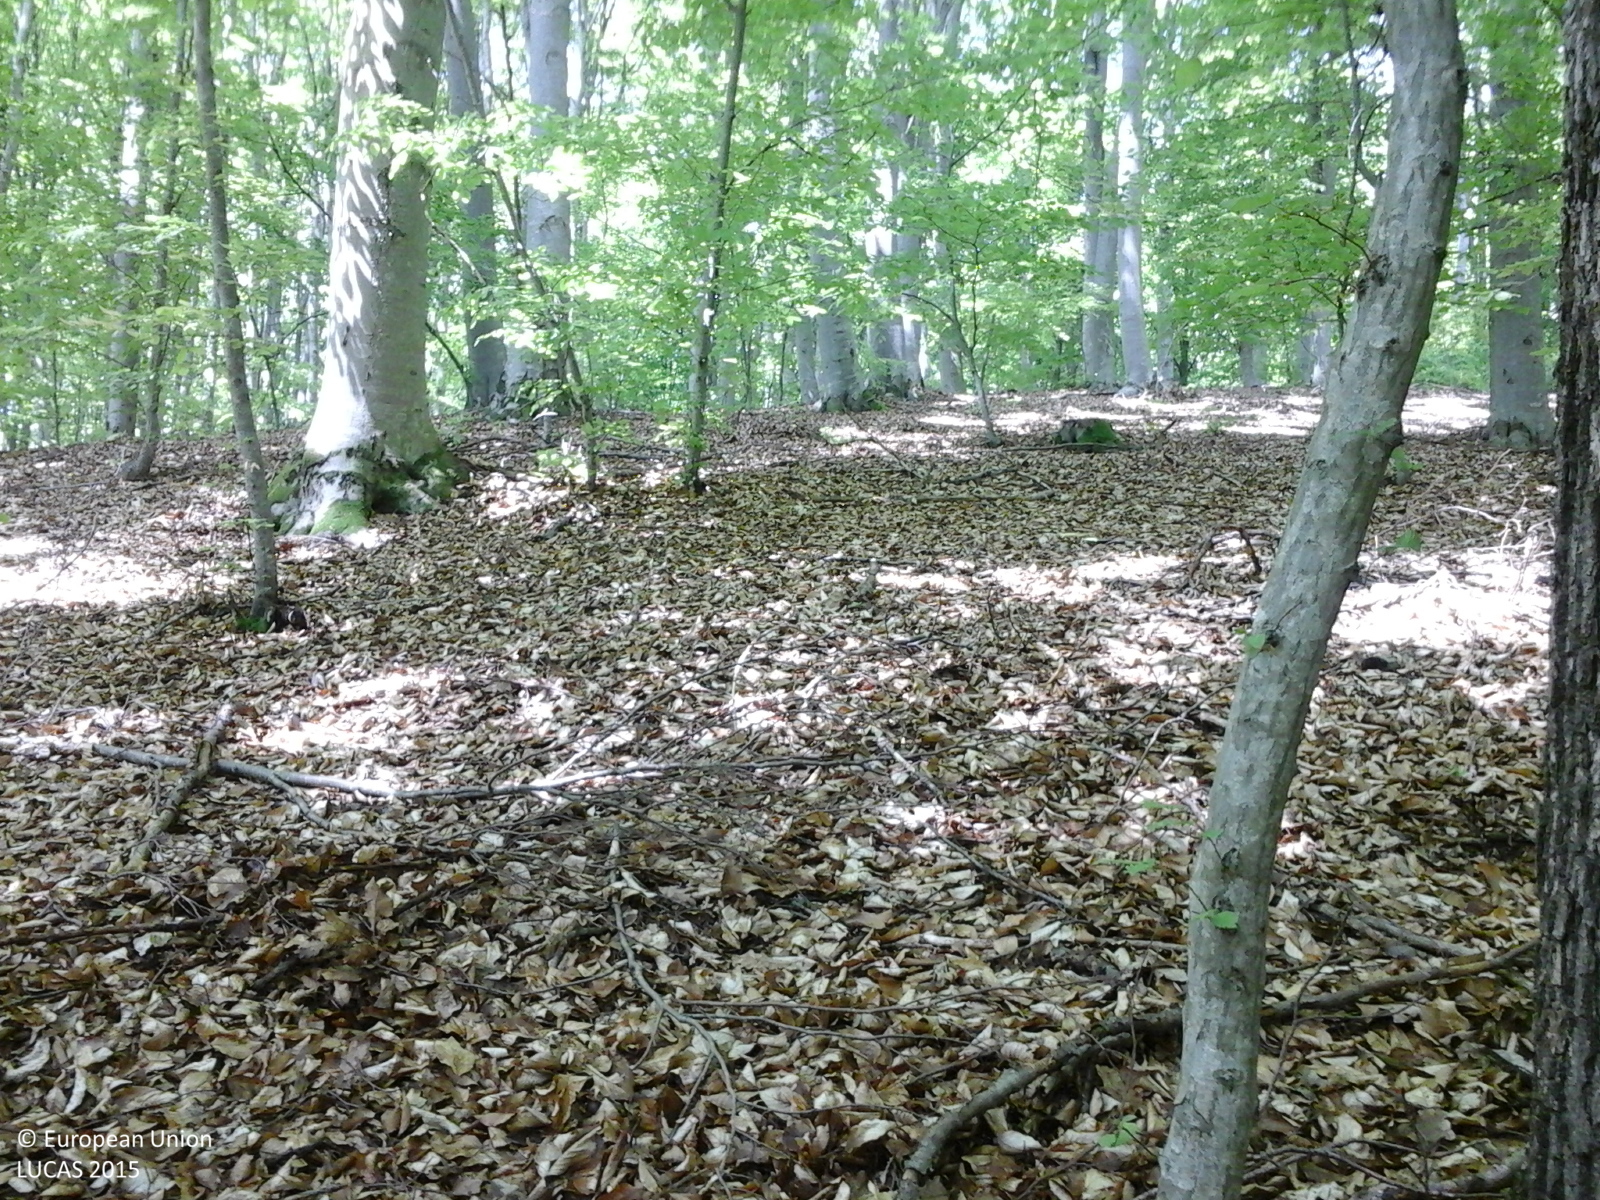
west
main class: Woodland
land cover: Broadleaved woodland
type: beech forest
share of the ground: > 75 %
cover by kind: broadleaved forest trees 100 %
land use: Forestry
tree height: > 5 m
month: May
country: RO
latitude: 45.8563
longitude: 25.7317
